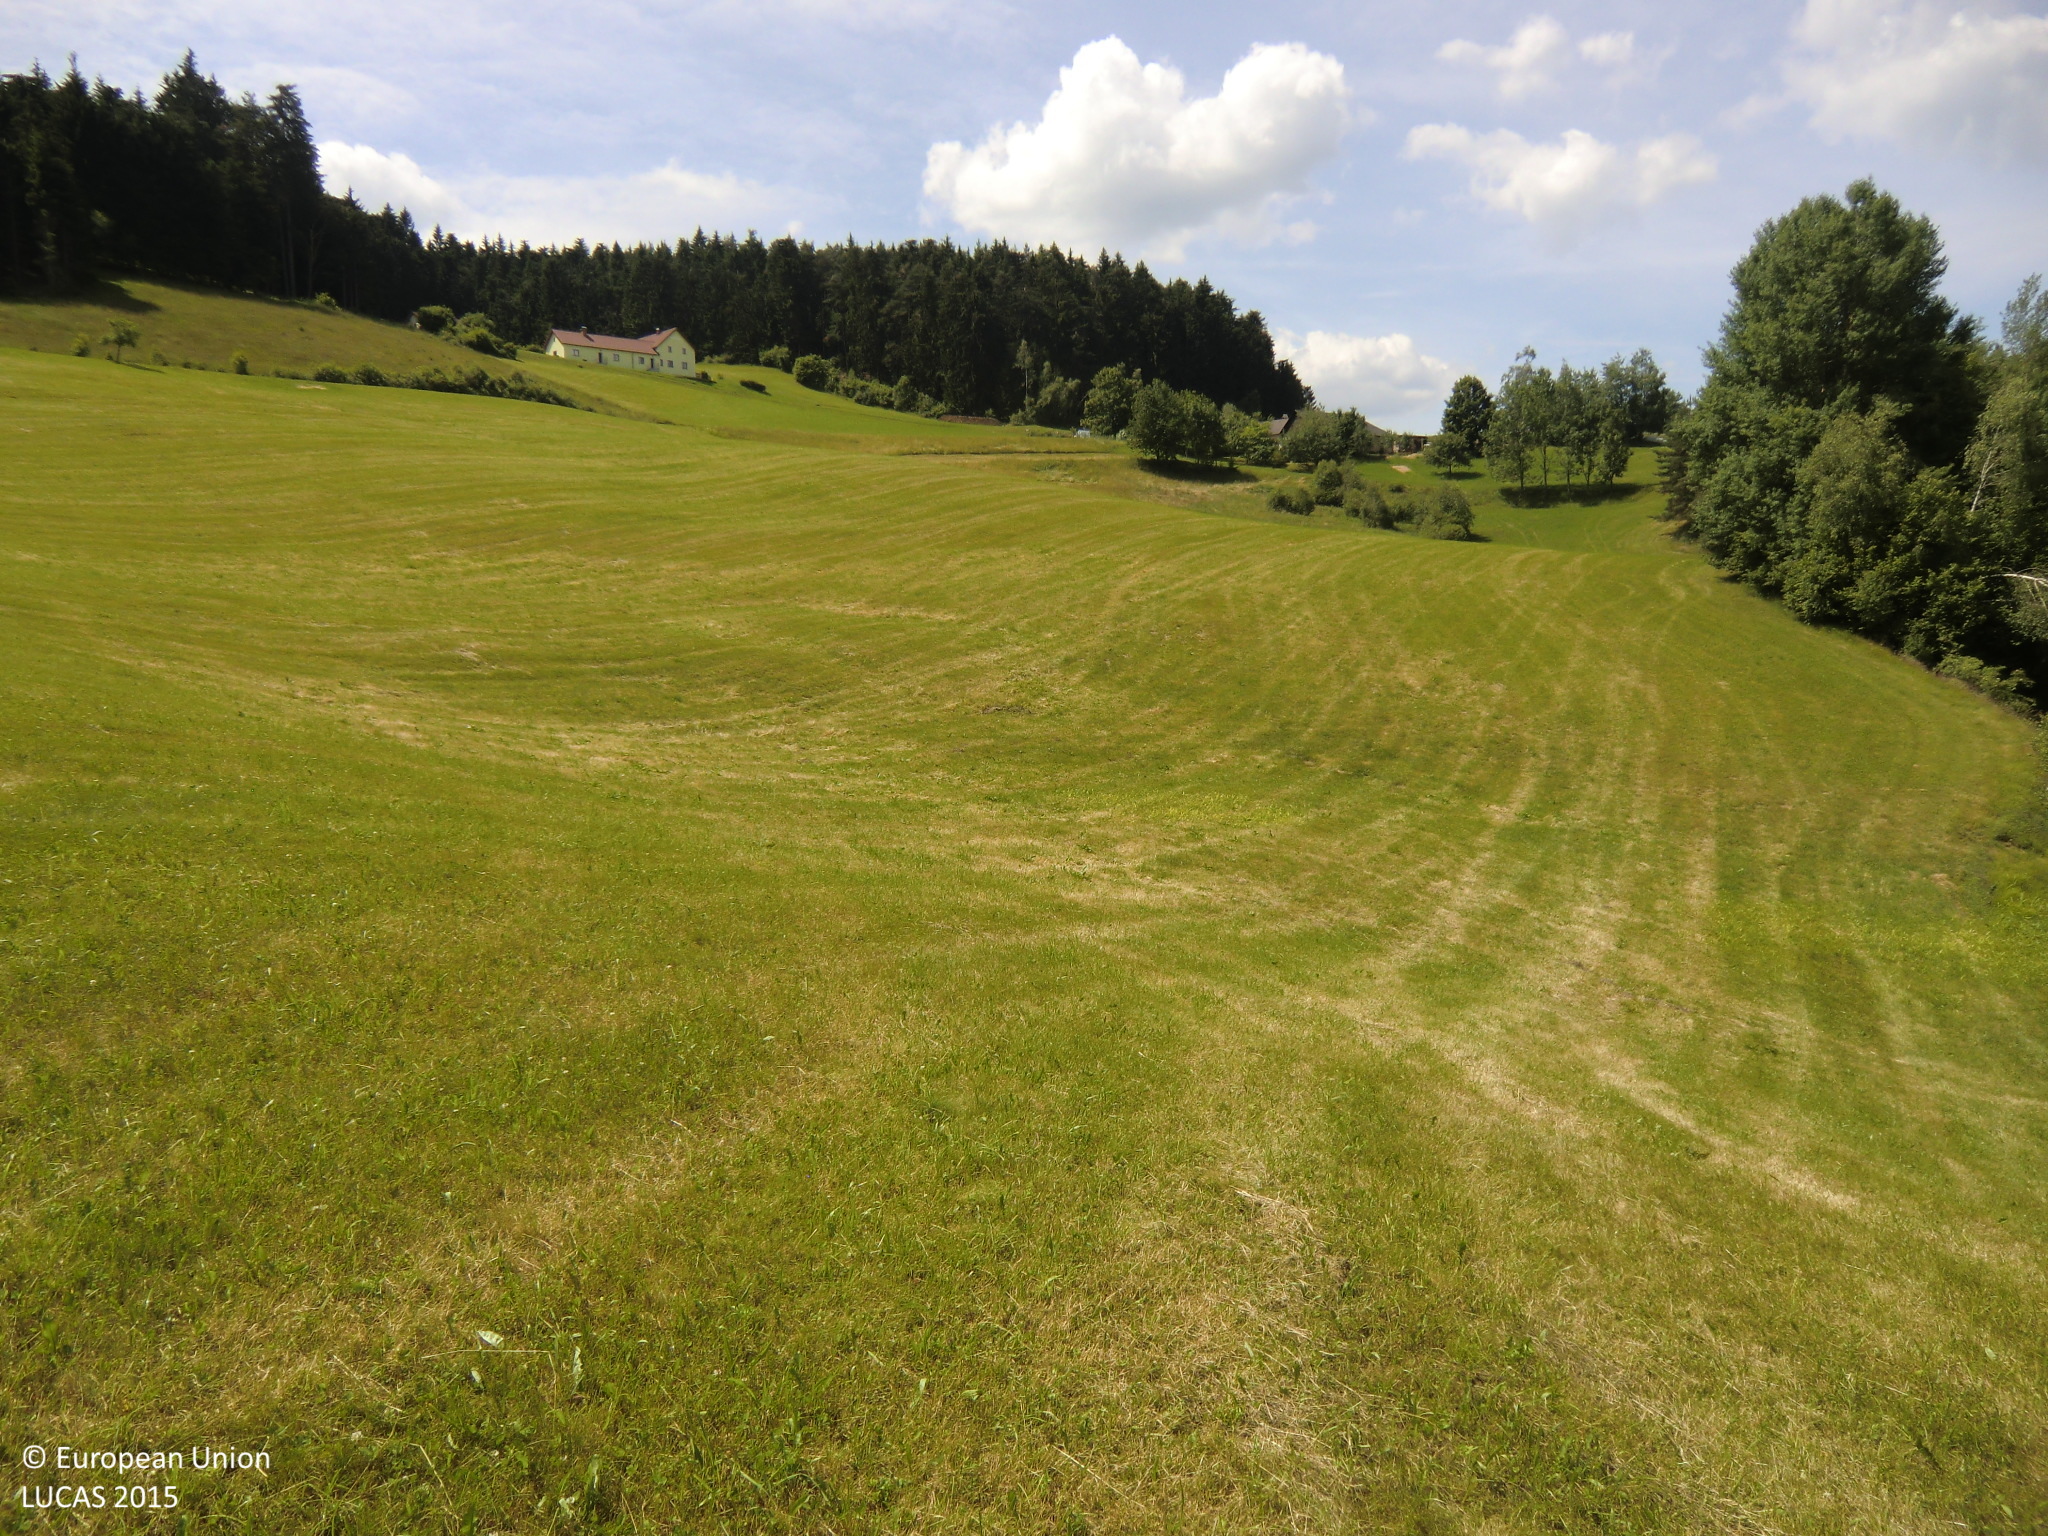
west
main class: Grassland
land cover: Grassland without tree/shrub cover
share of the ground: > 75 %
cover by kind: herbaceous plants 100 %
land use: Agriculture (excluding fallow land and kitchen gardens)
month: June
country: AT
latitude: 48.5224
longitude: 15.0520
